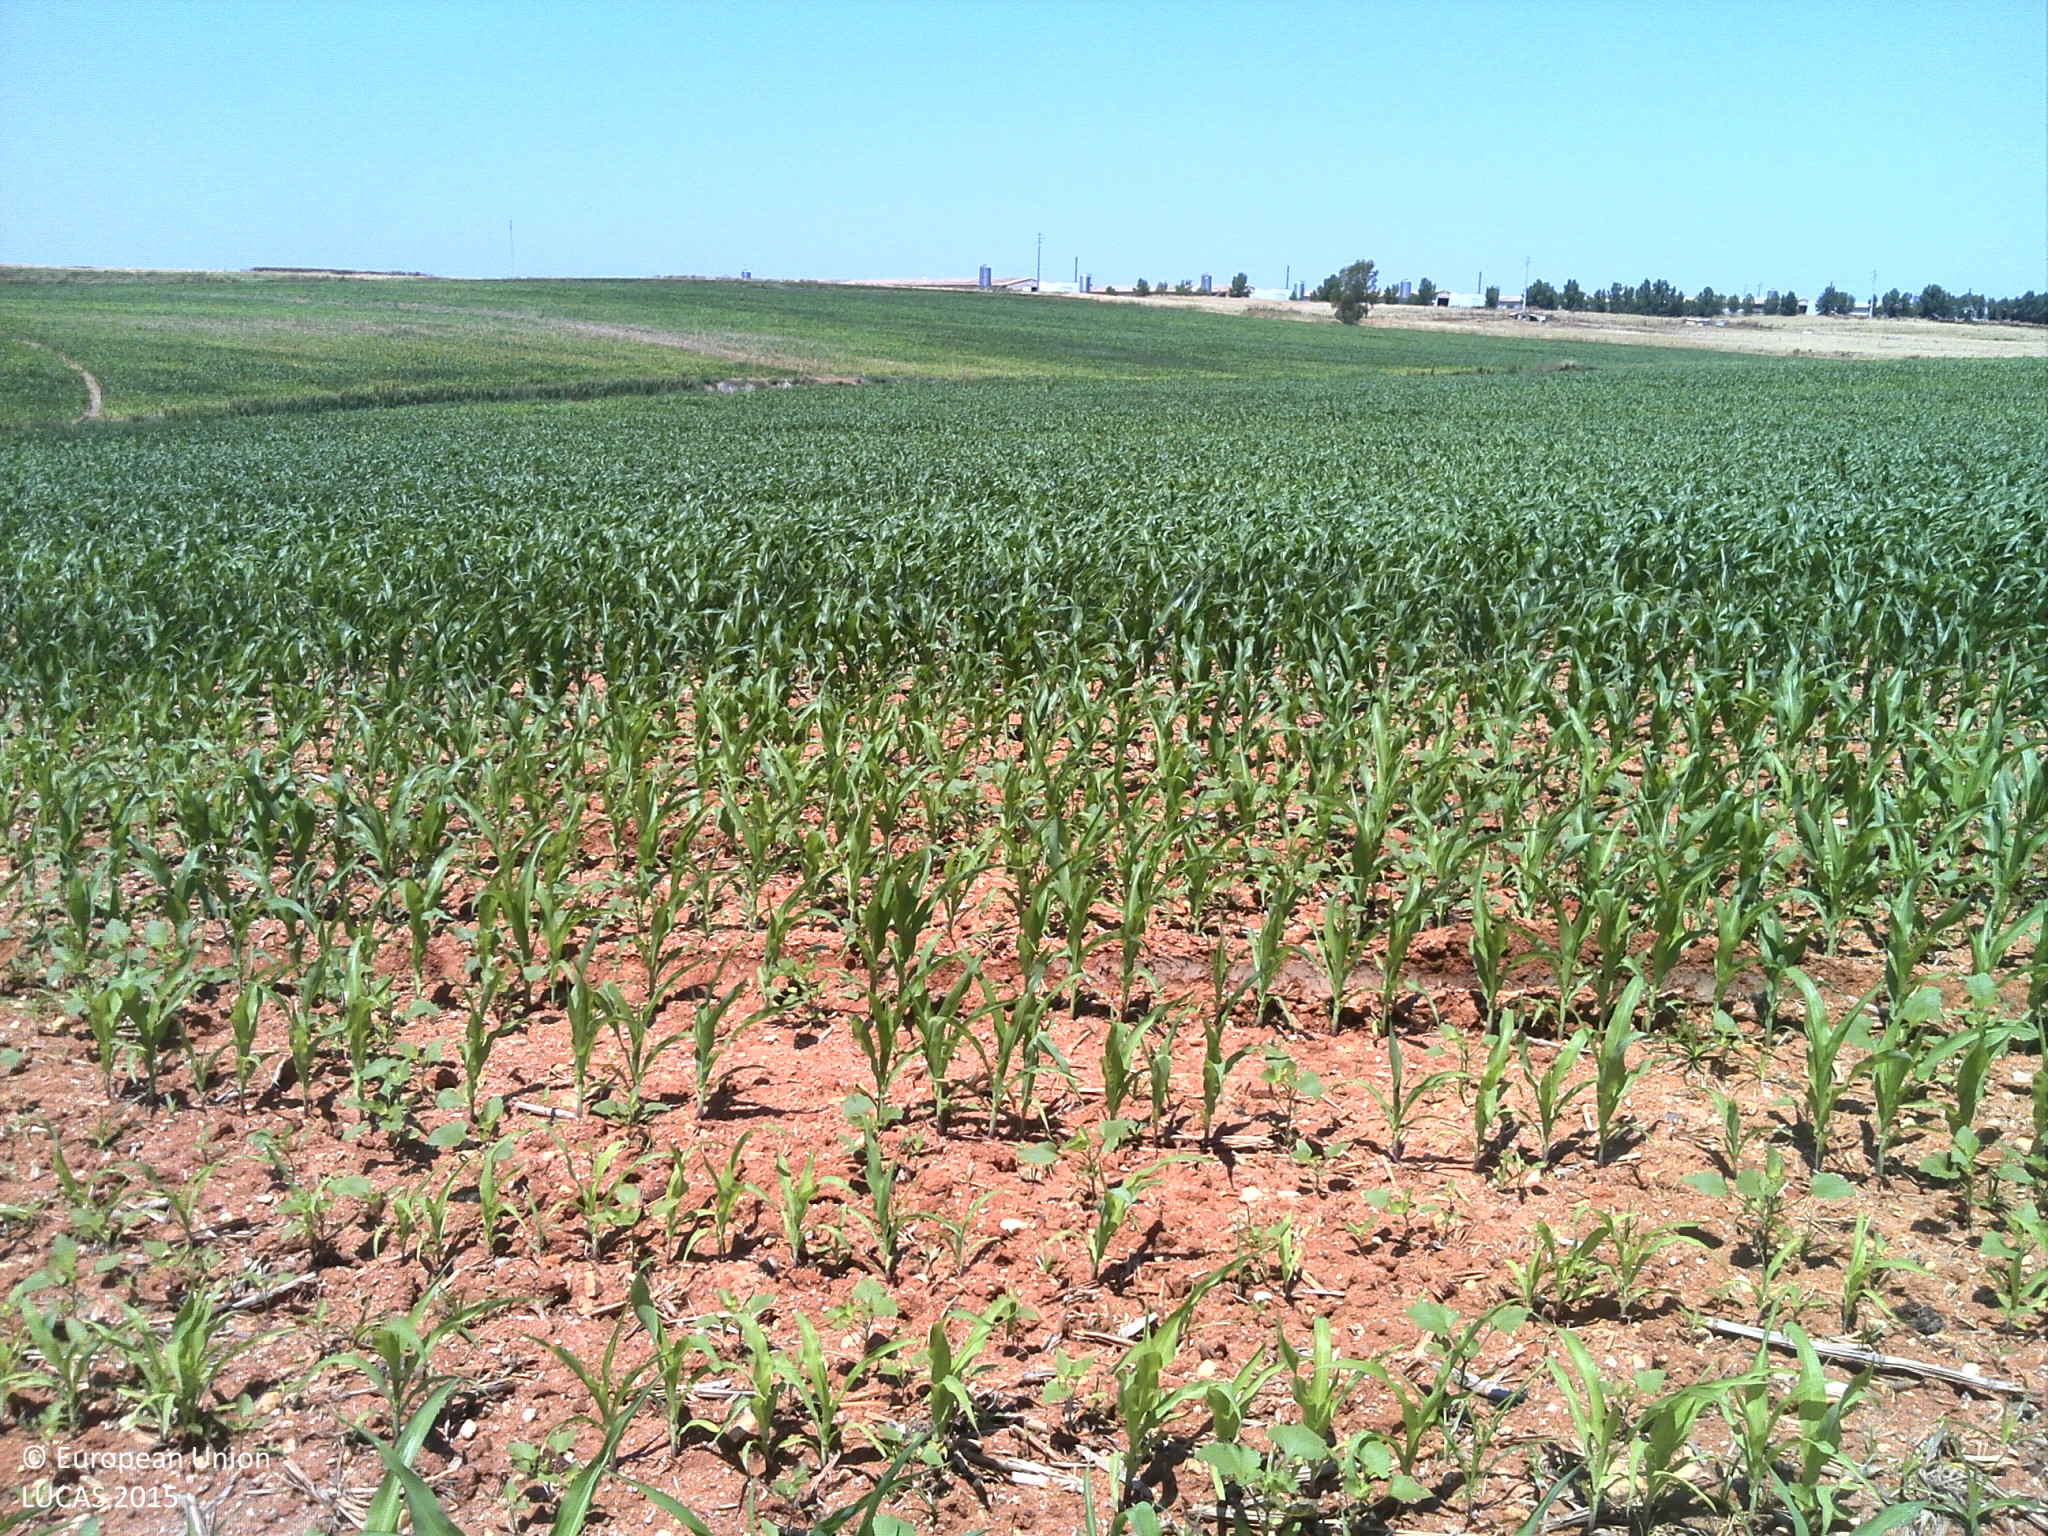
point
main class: Cropland
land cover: Maize
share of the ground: 10 - 25 %
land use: Agriculture (excluding fallow land and kitchen gardens)
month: June
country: PT
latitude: 37.9113
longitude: -8.3382
